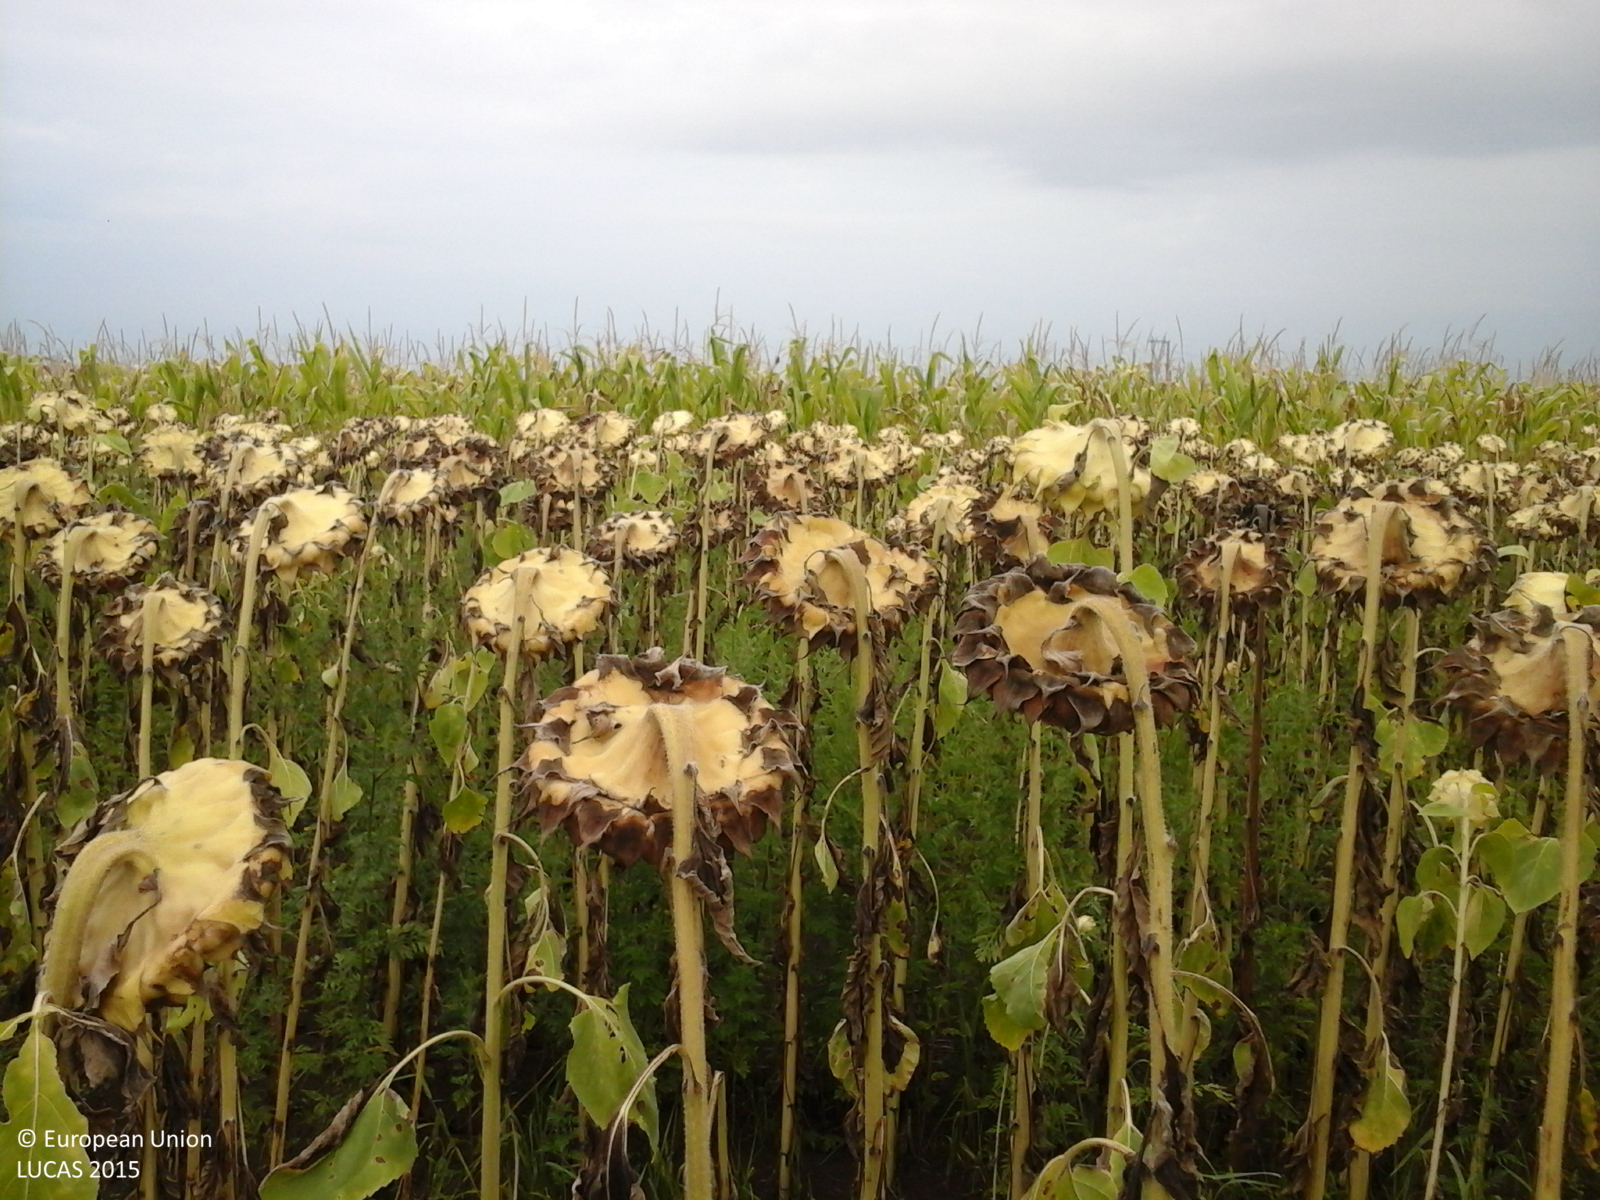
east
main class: Cropland
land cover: Sunflower
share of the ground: > 75 %
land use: Agriculture (excluding fallow land and kitchen gardens)
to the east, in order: Sunflower; Maize; Soya; Spontaneously vegetated surfaces; Sunflower; Common wheat; Lucerne
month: August
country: RO
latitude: 45.7839
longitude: 21.4943
